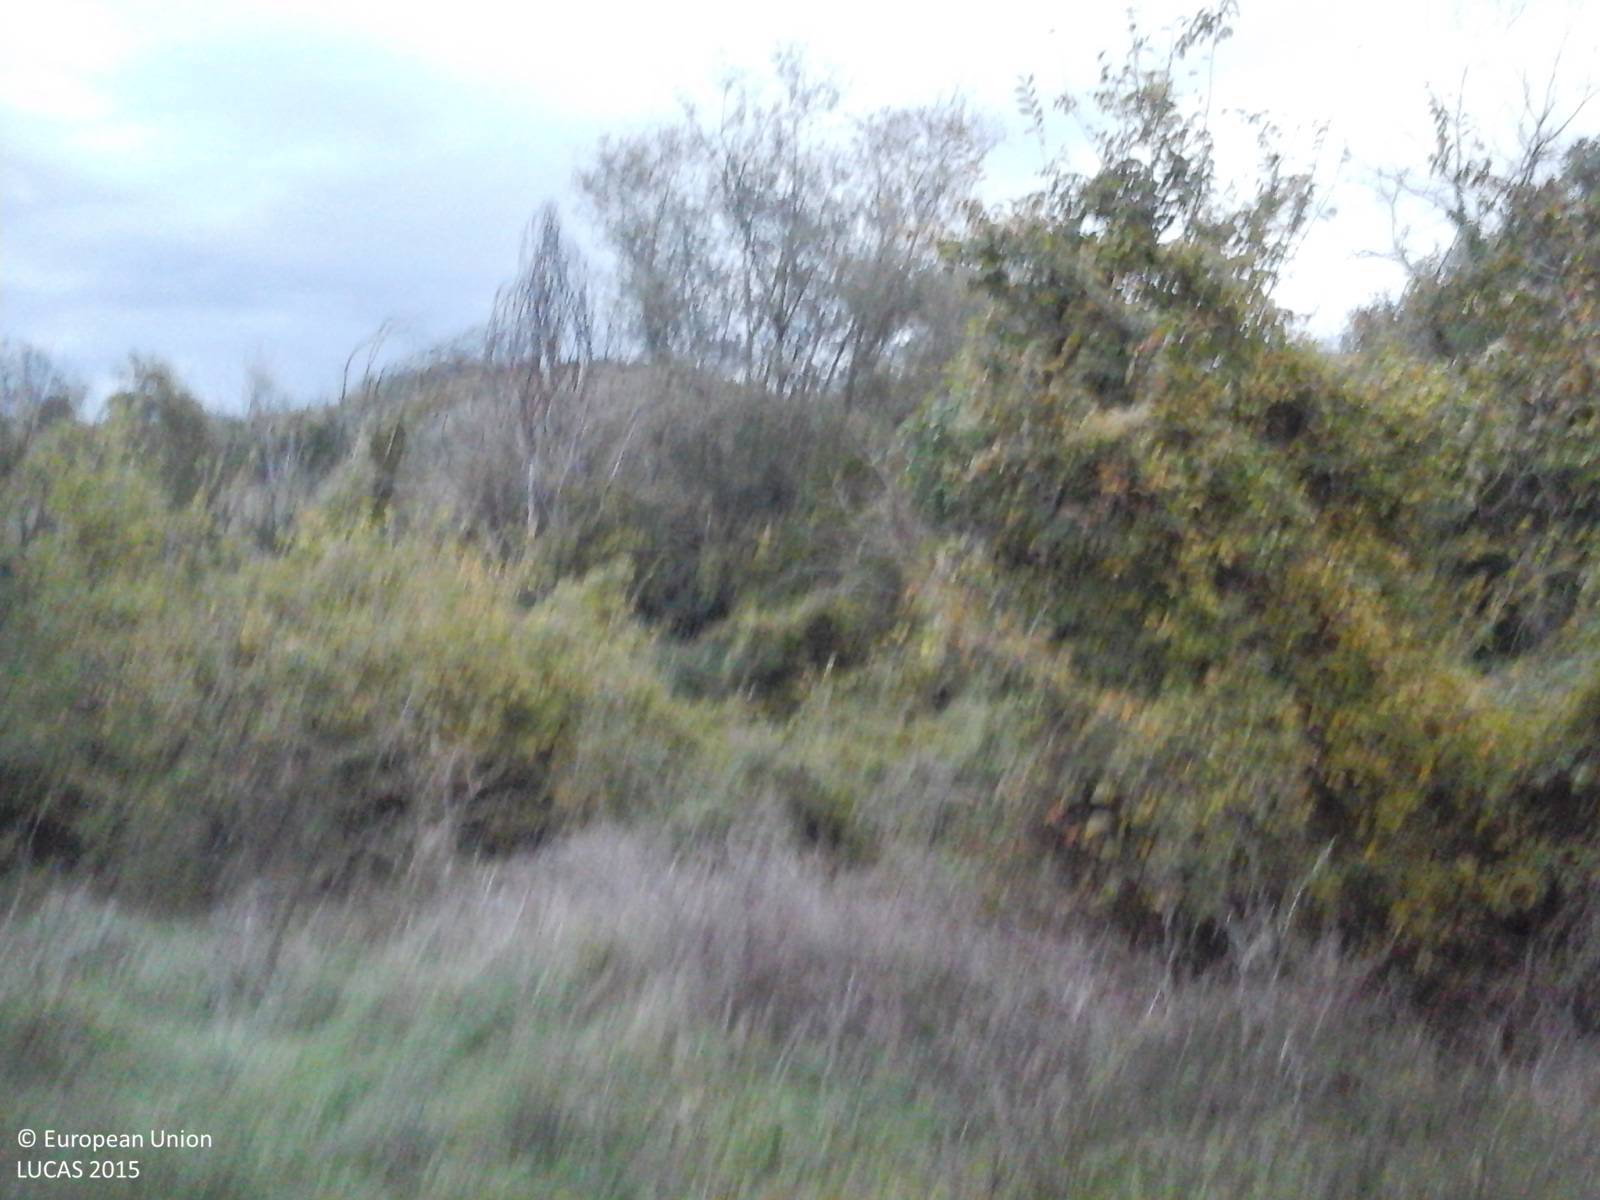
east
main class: Woodland
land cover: Broadleaved woodland
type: thermophilous deciduous forest
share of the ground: > 75 %
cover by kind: broadleaved forest trees 95 %, shrubs 5 %
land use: Forestry
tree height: > 5 m
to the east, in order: Broadleaved woodland; Lucerne; Broadleaved woodland
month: October
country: IT
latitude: 42.6105
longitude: 12.2721
